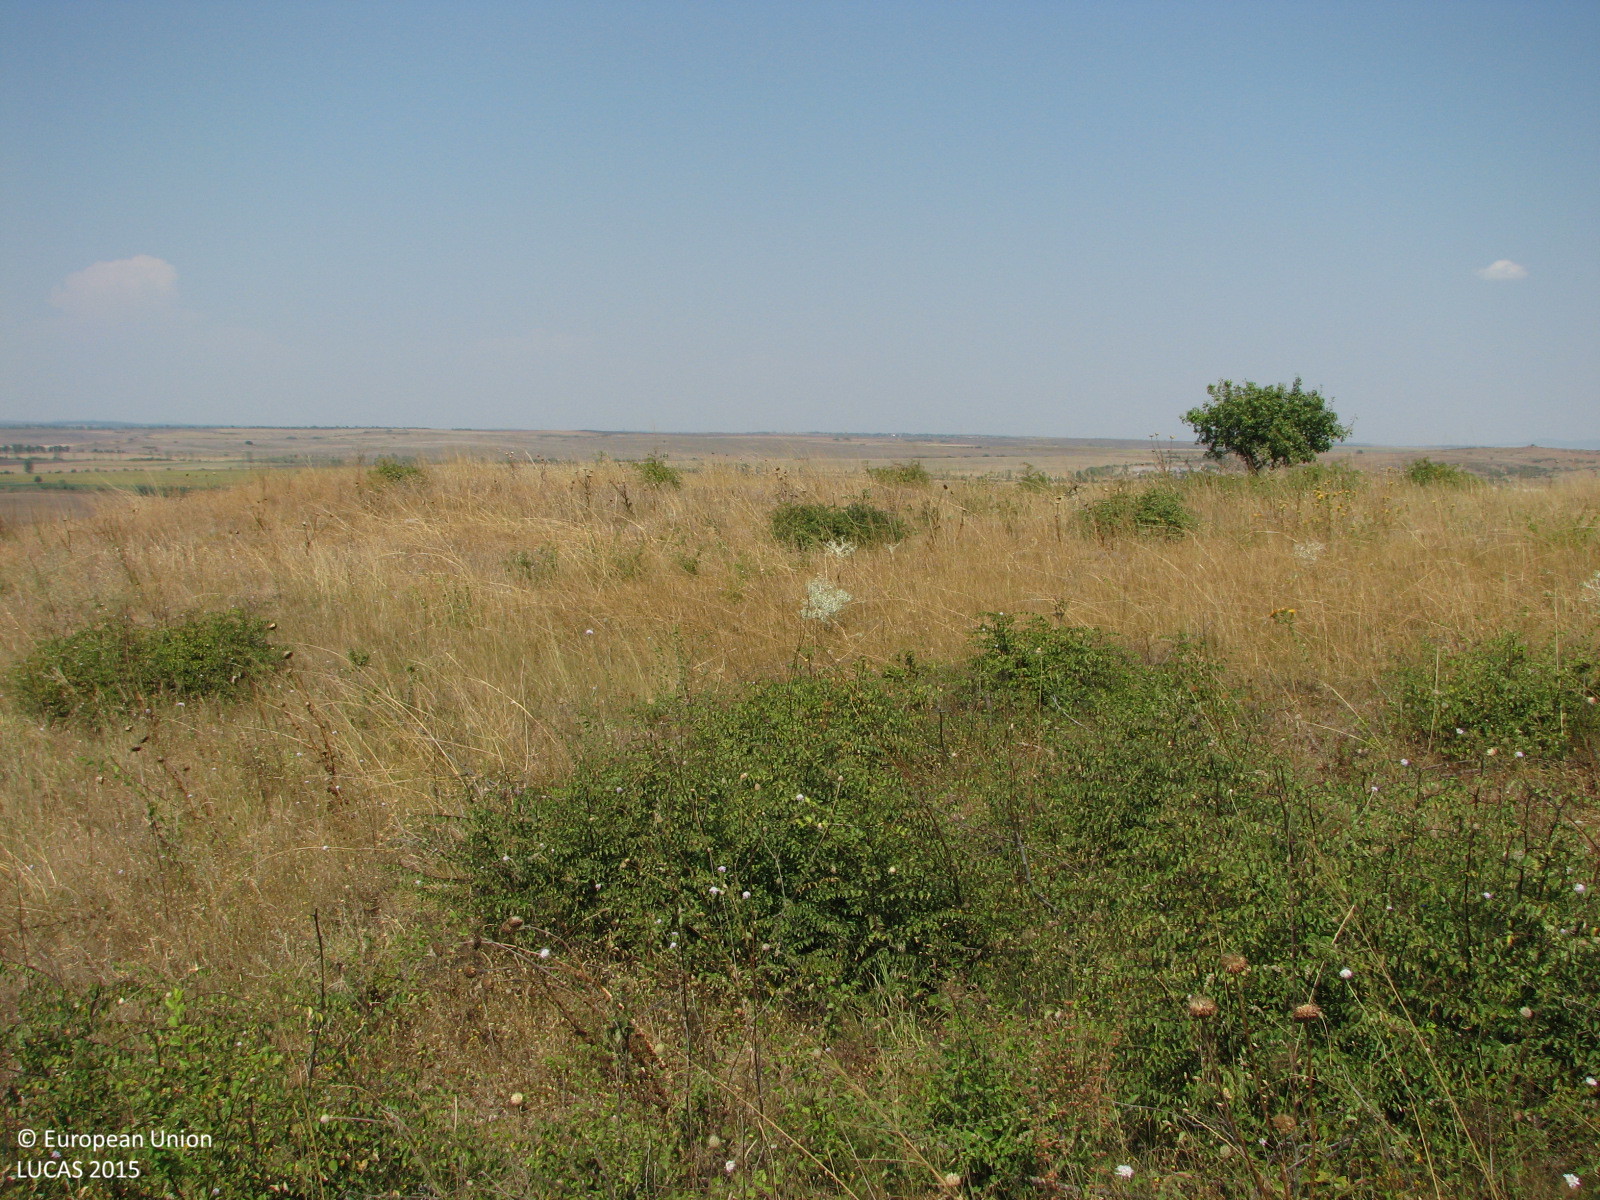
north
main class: Grassland
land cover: Grassland with sparse tree/shrub cover
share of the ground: > 75 %
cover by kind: herbaceous plants 90 %, broadleaved forest trees 5 %, shrubs 5 %
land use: Agriculture (excluding fallow land and kitchen gardens)
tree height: < 5 m
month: August
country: BG
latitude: 42.1466
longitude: 26.6571
